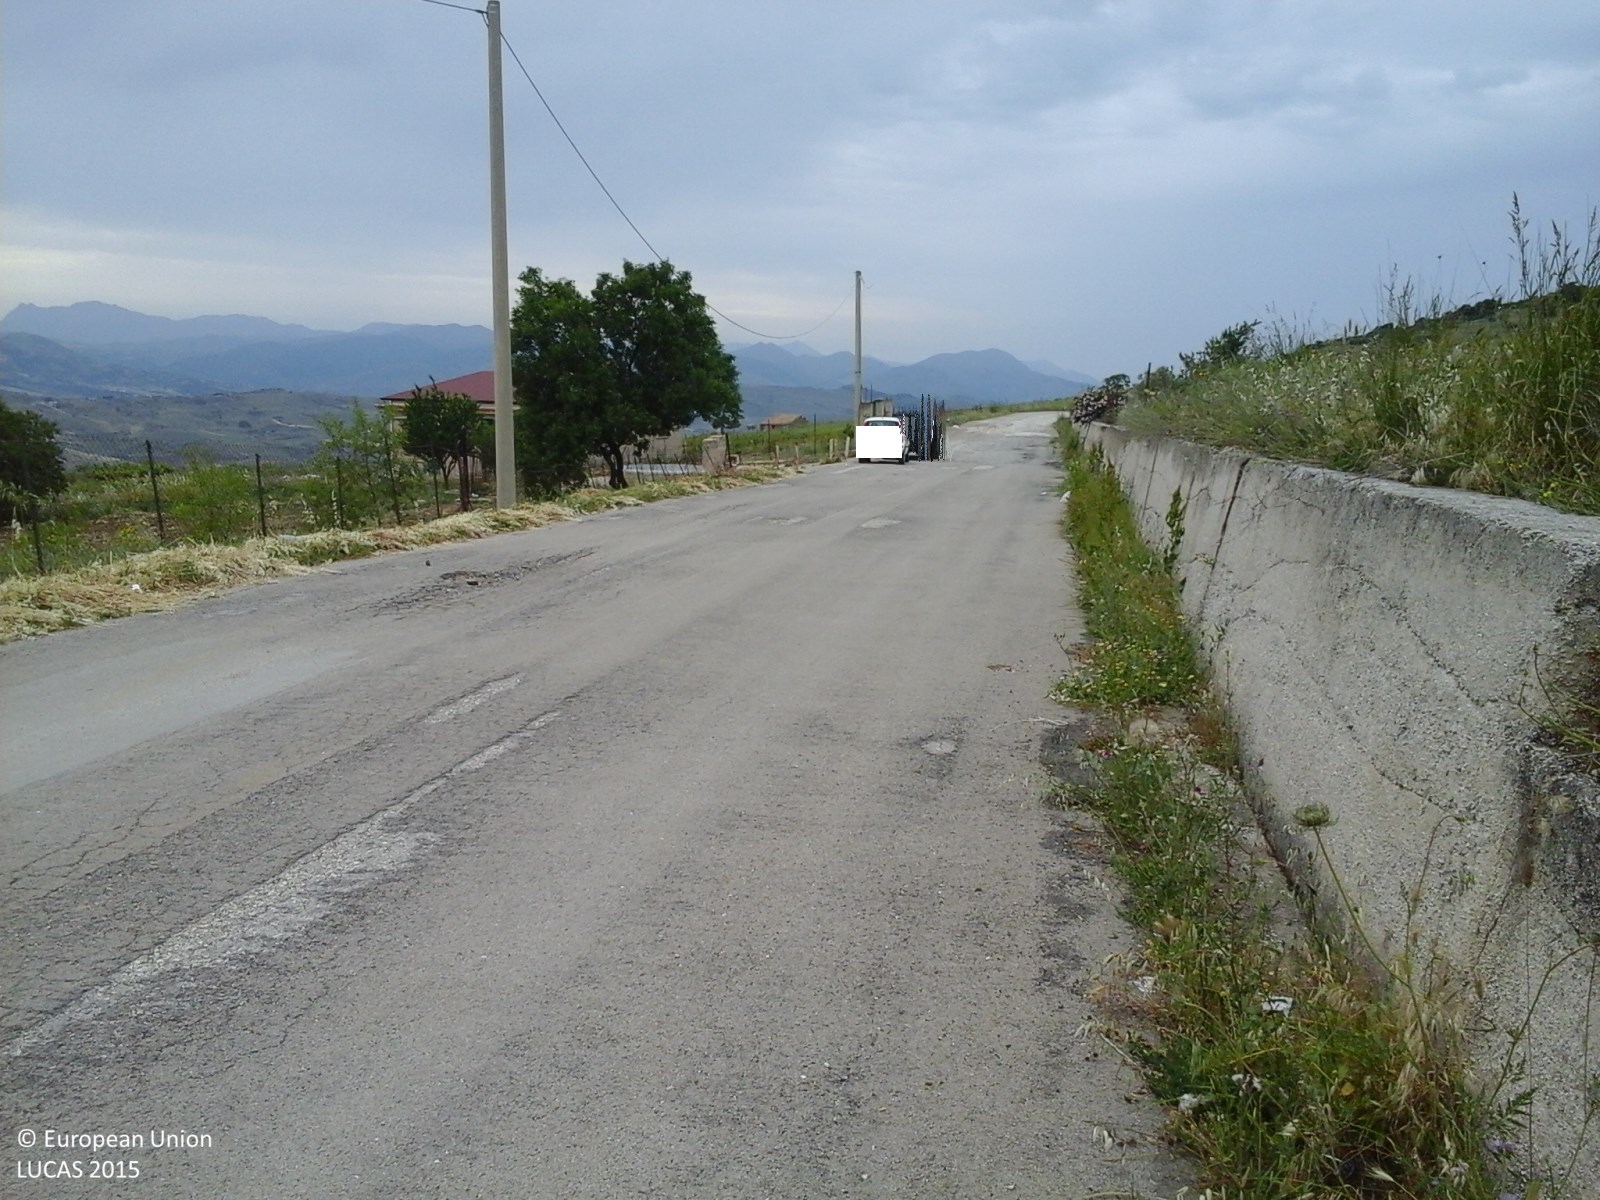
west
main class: Cropland
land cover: Other leguminous and mixtures for fodder
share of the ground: > 75 %
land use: Agriculture (excluding fallow land and kitchen gardens)
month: May
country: IT
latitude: 37.9353
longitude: 13.5587
